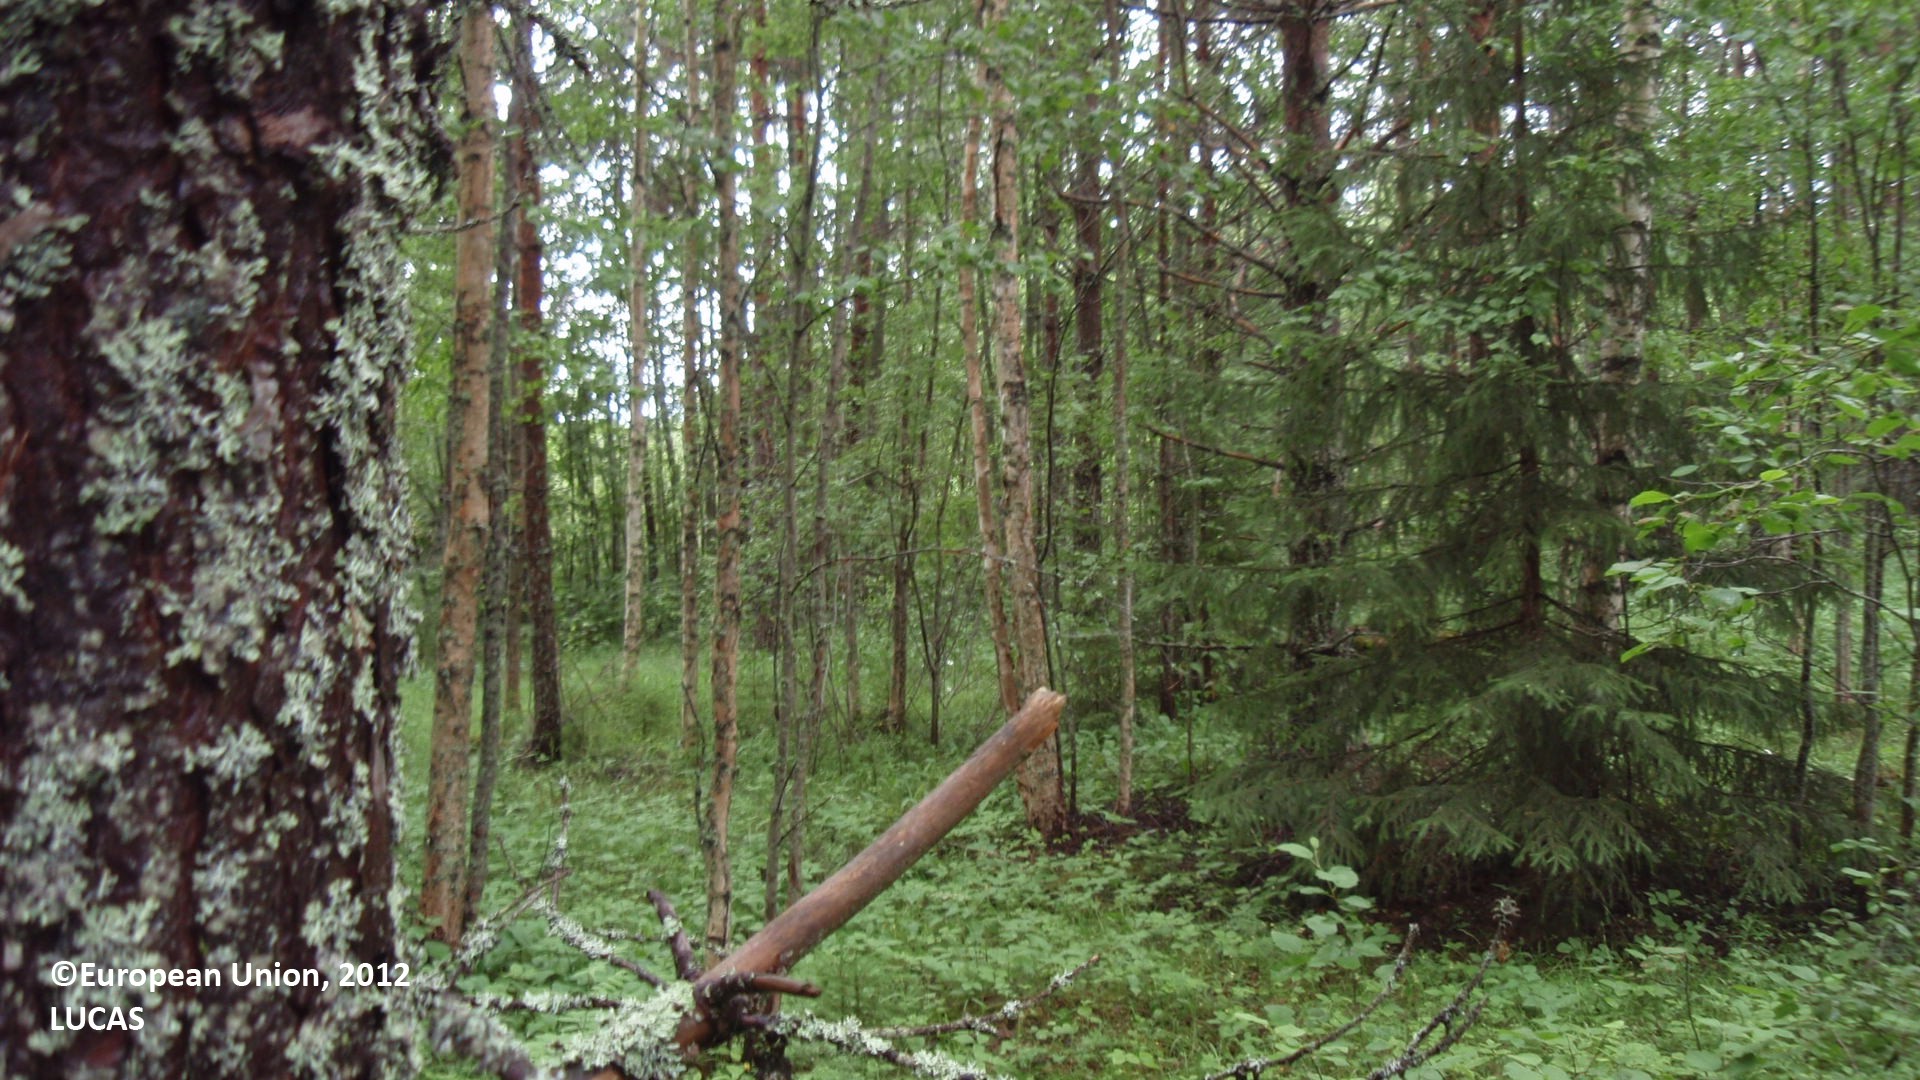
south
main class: Woodland
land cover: Pine dominated mixed woodland
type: boreal forest
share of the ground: > 75 %
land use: Forestry
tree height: > 5 m
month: July
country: FI
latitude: 61.4763
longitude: 26.9237
